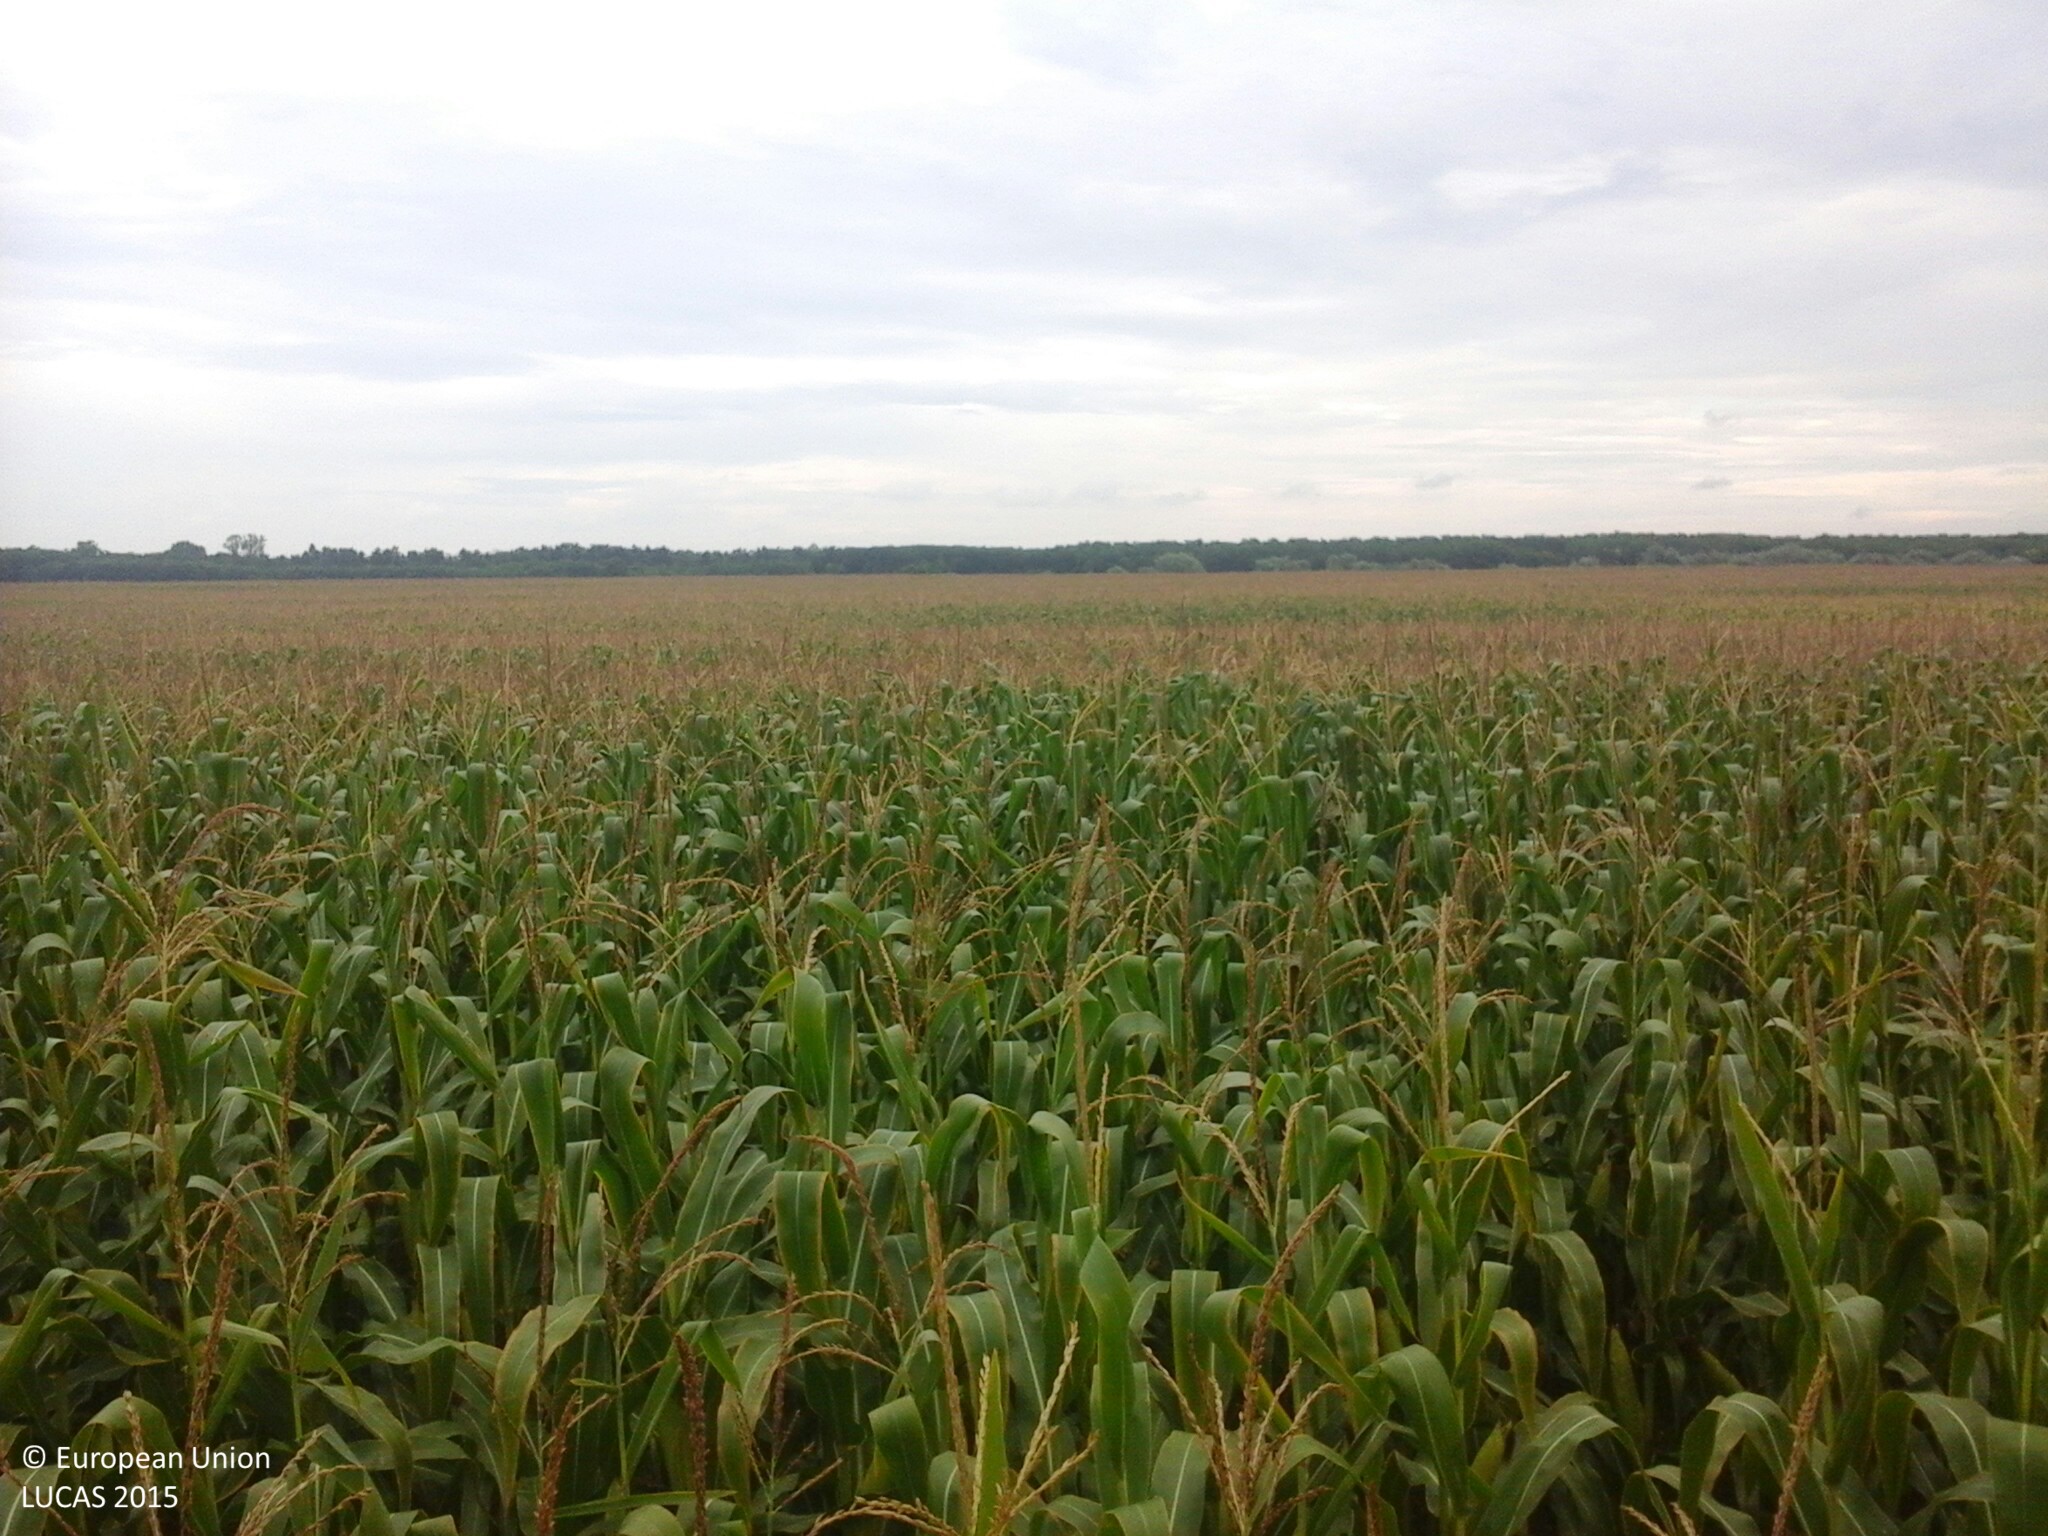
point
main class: Cropland
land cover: Maize
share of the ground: > 75 %
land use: Agriculture (excluding fallow land and kitchen gardens)
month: July
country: HU
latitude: 47.0641
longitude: 18.4785
